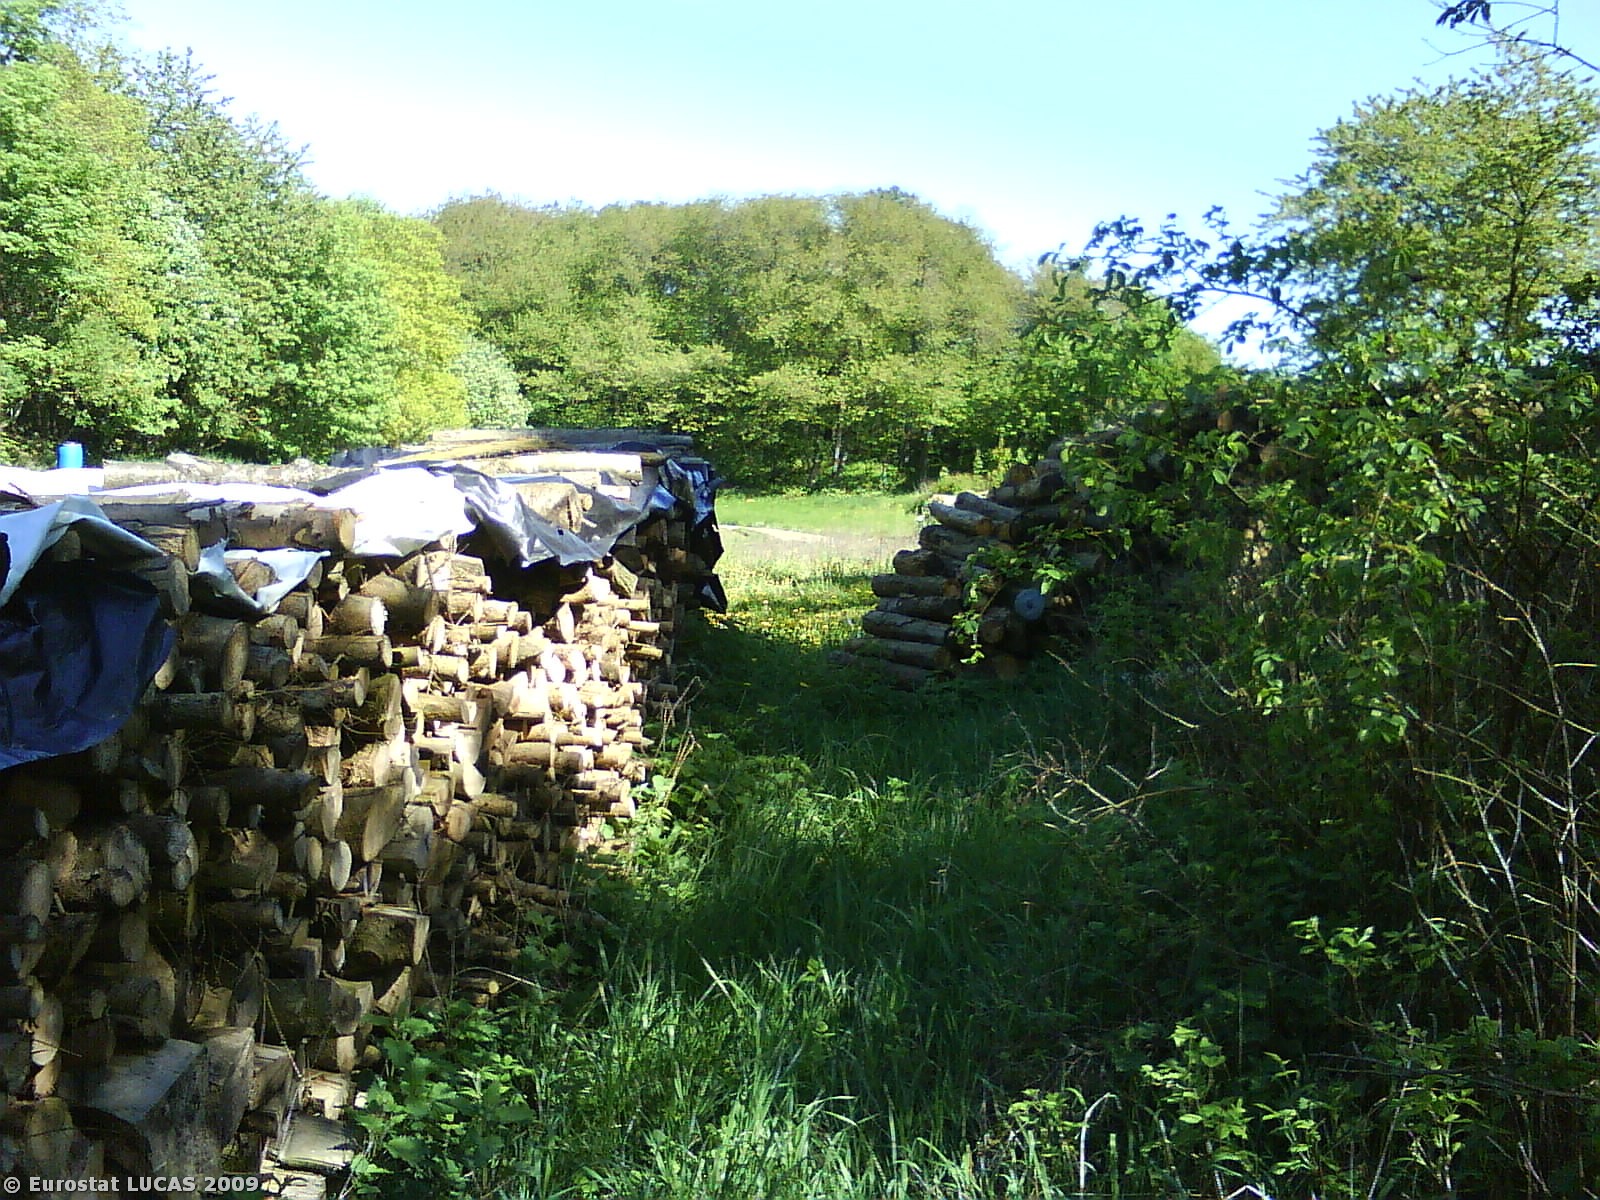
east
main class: Woodland
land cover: Broadleaved woodland
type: plantations and self-sown exotic forest
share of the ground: 25 - 50 %
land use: Forestry
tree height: > 5 m
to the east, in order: Broadleaved woodland; Grassland without tree/shrub cover; Tracks; Grassland without tree/shrub cover; Maize; Broadleaved woodland; Grassland without tree/shrub cover; Tracks; Grassland without tree/shrub cover; Broadleaved woodland; Tracks; Coniferous woodland; Tracks; Broadleaved woodland; Grass margins; Paved roads, cycling and walking lanes; Grass margins; Common wheat
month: May
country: DK
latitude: 56.4549
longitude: 10.7941
